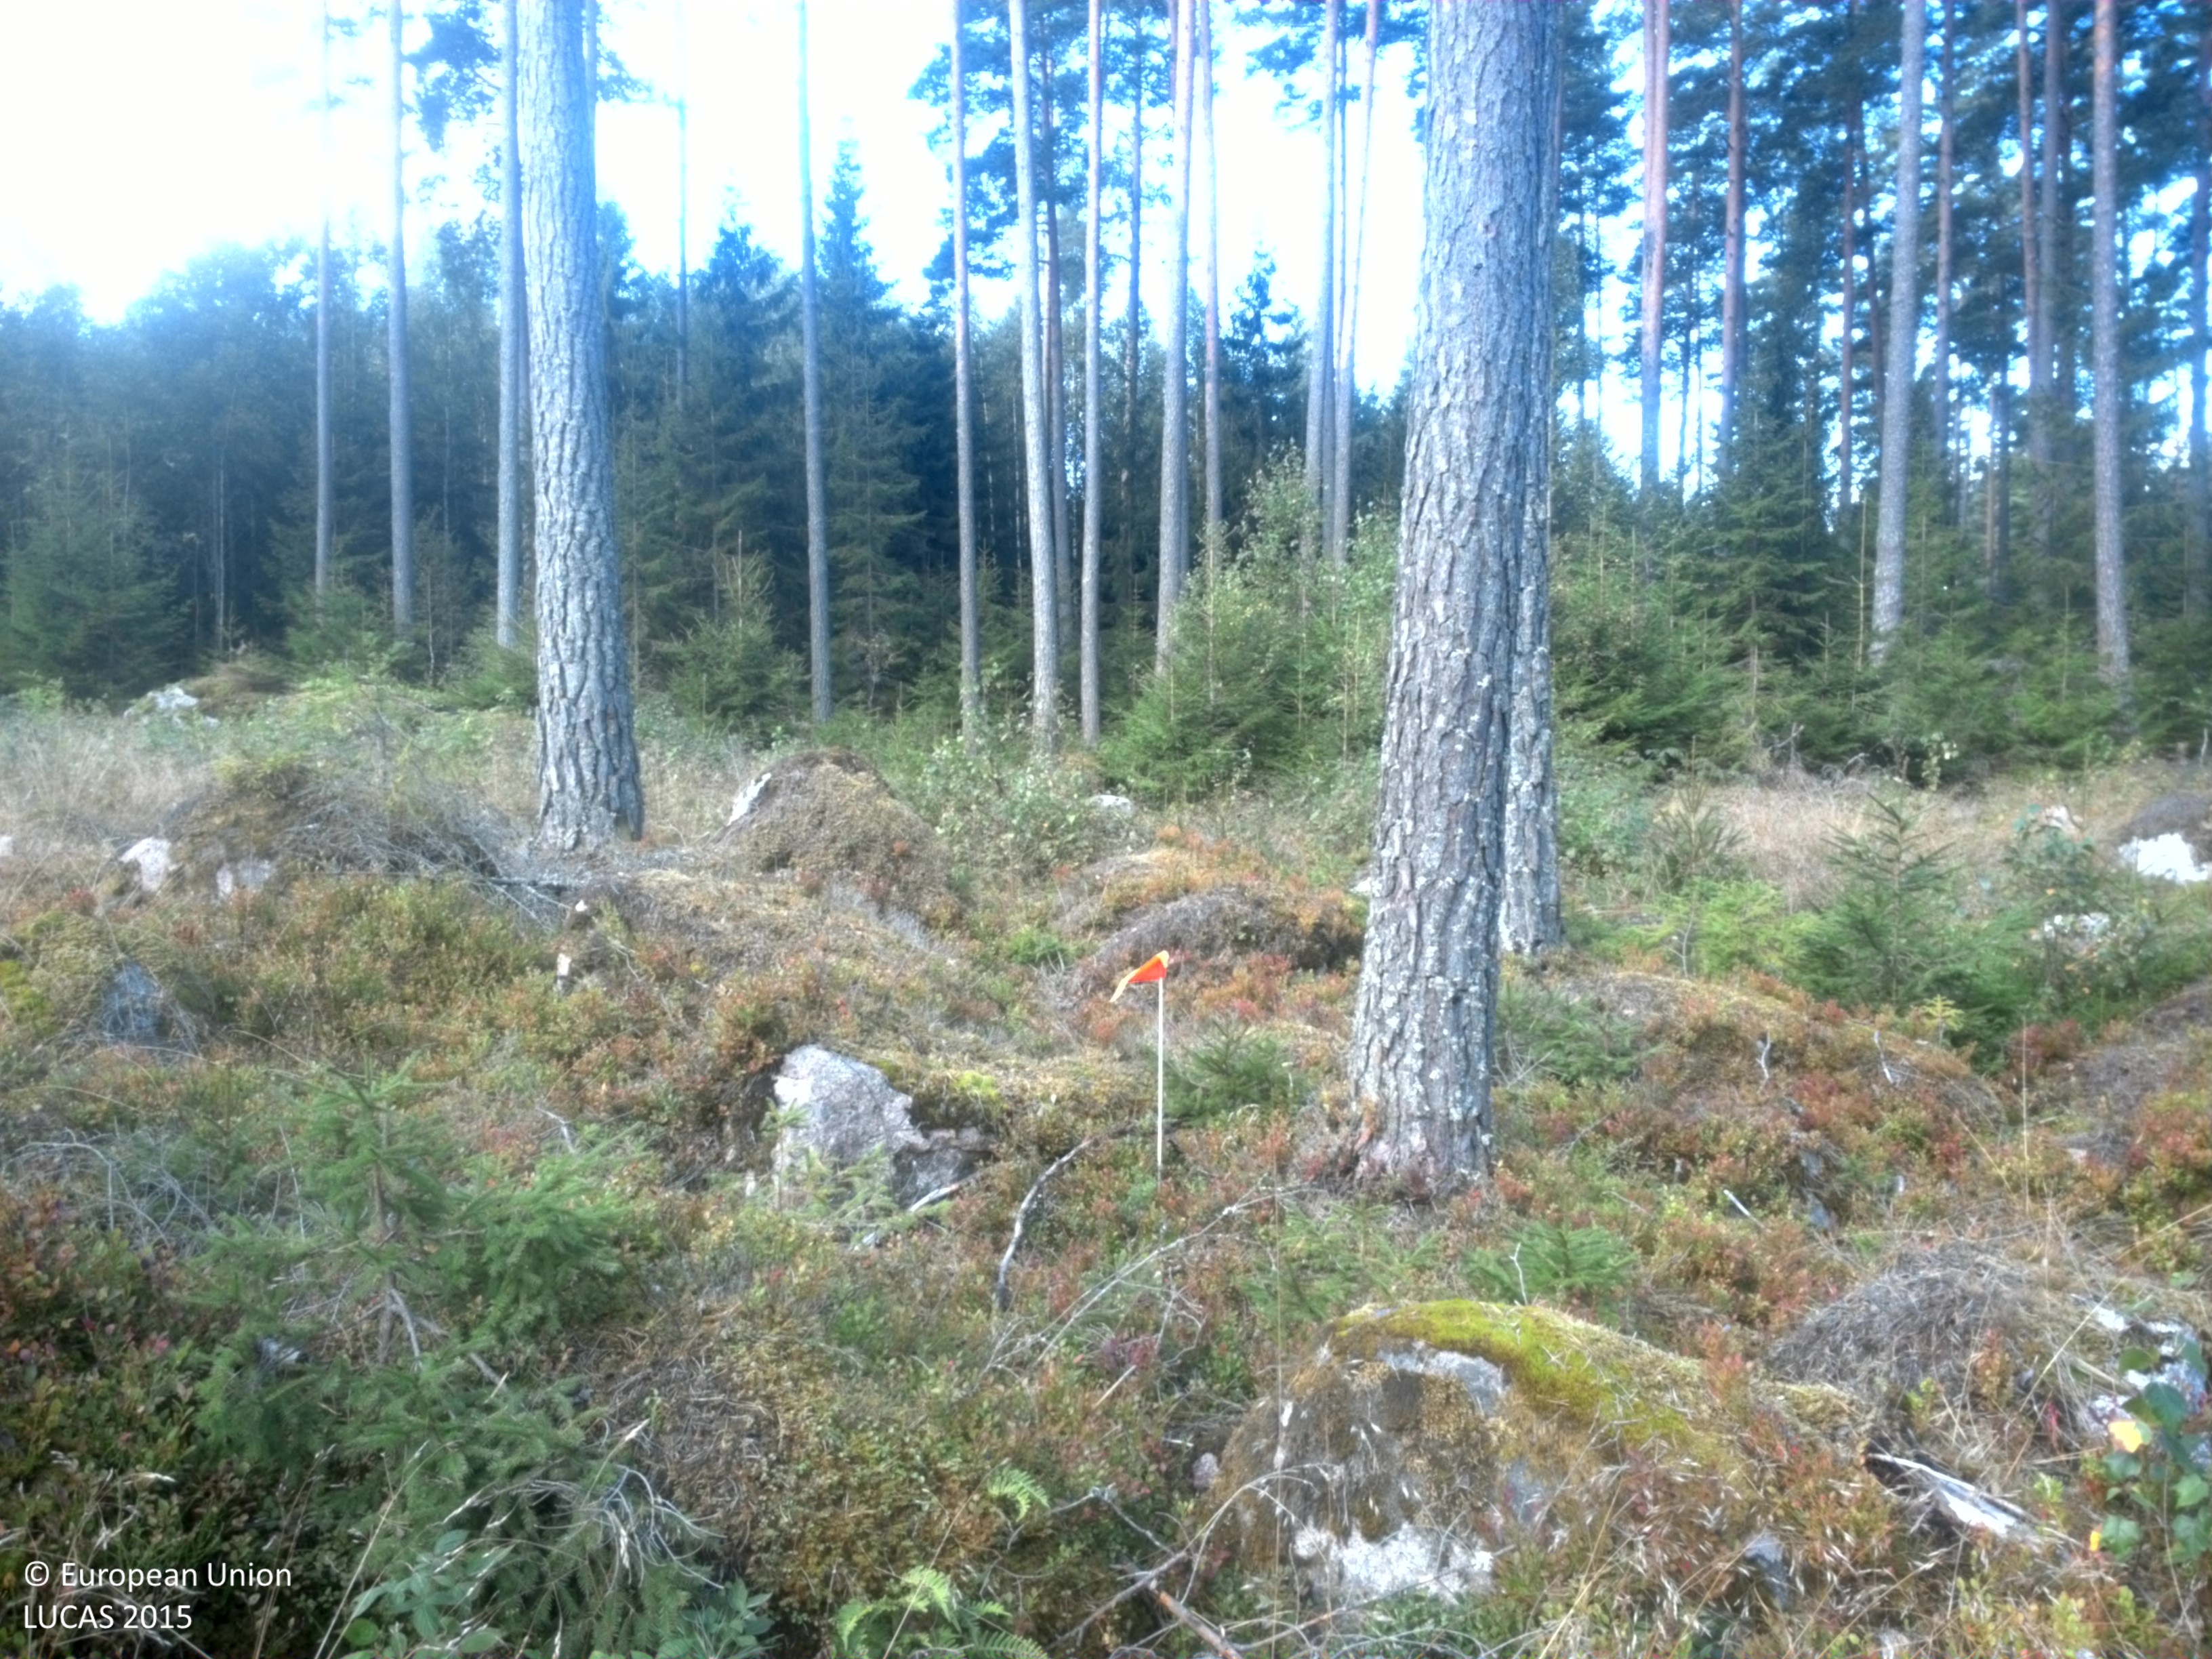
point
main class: Woodland
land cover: Pine dominated coniferous woodland
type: boreal forest
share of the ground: 50 - 75 %
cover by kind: coniferous forest trees 50 %, shrubs 25 %, herbaceous plants 15 %, broadleaved forest trees 5 %, lichens and mosses 5 %
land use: Forestry
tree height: > 5 m
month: September
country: SE
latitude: 59.5433
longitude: 15.6686
